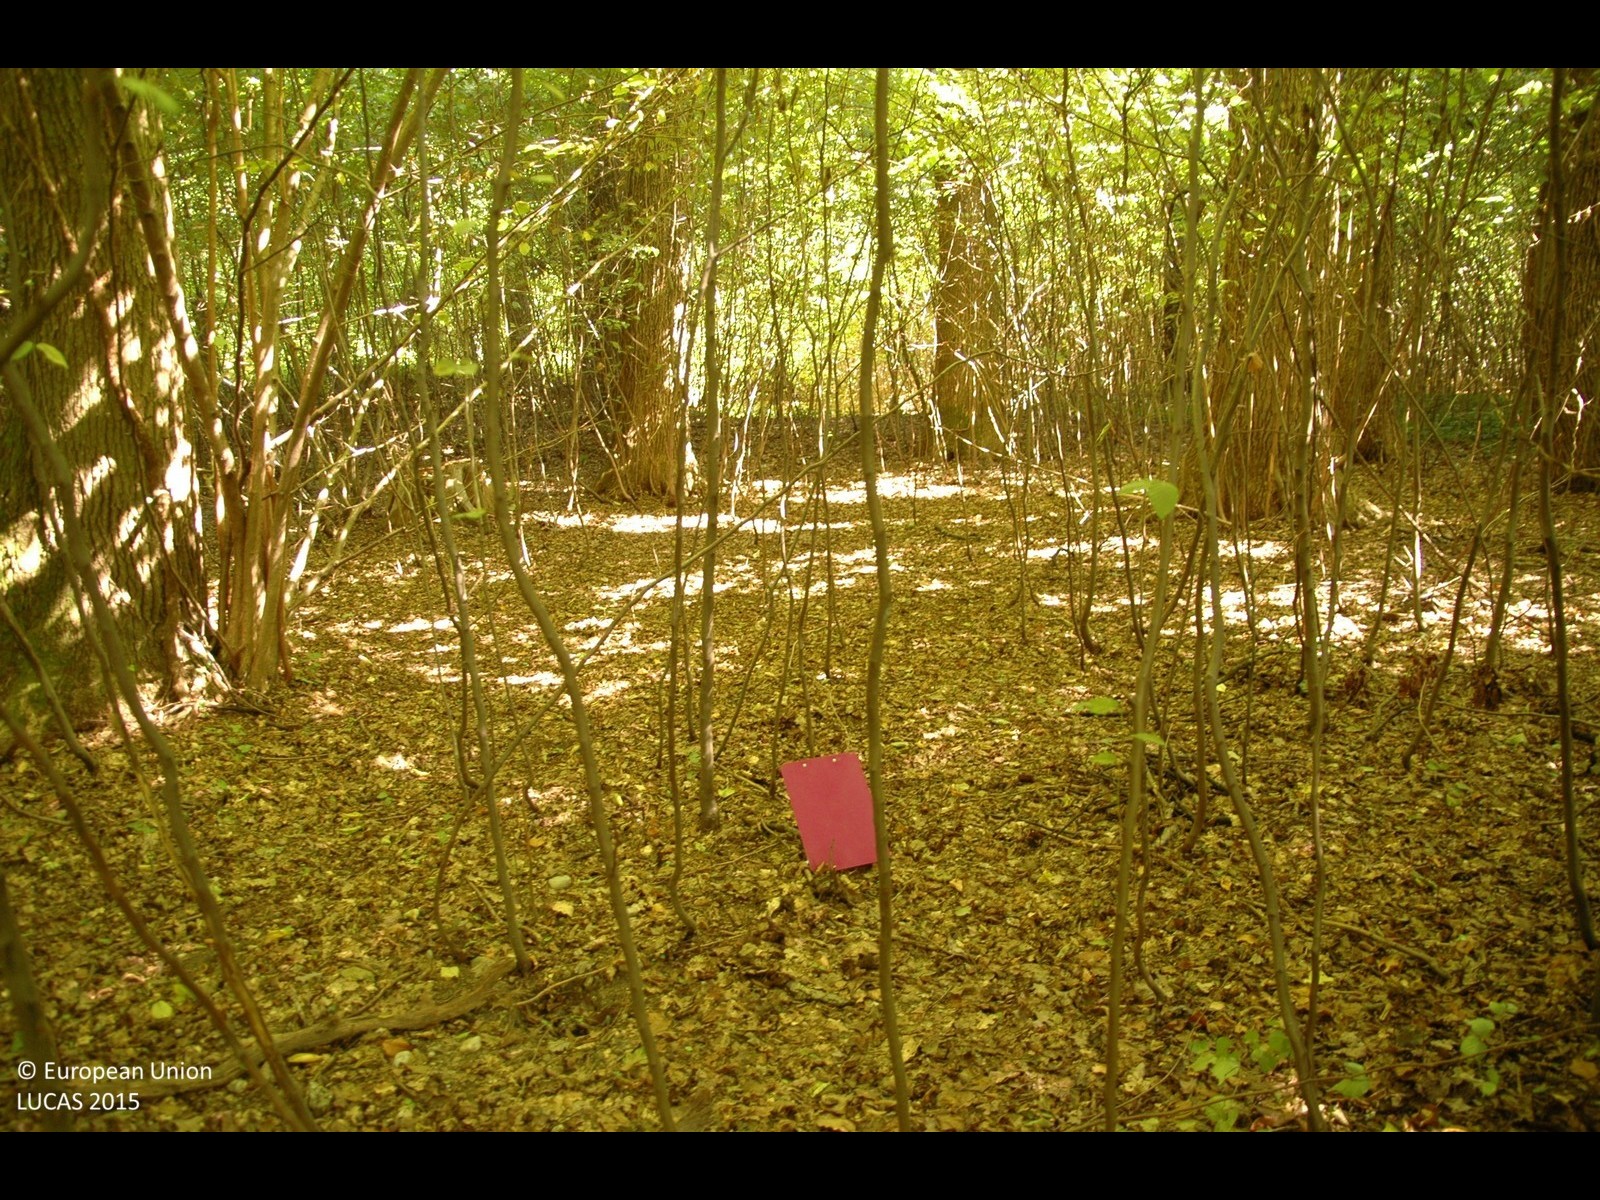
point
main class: Woodland
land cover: Broadleaved woodland
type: mesophytic deciduous forest
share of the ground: > 75 %
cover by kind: broadleaved forest trees 100 %
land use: Semi-natural and natural areas not in use
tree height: > 5 m
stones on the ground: < 10 %
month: August
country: HR
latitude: 46.1529
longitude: 16.7989
